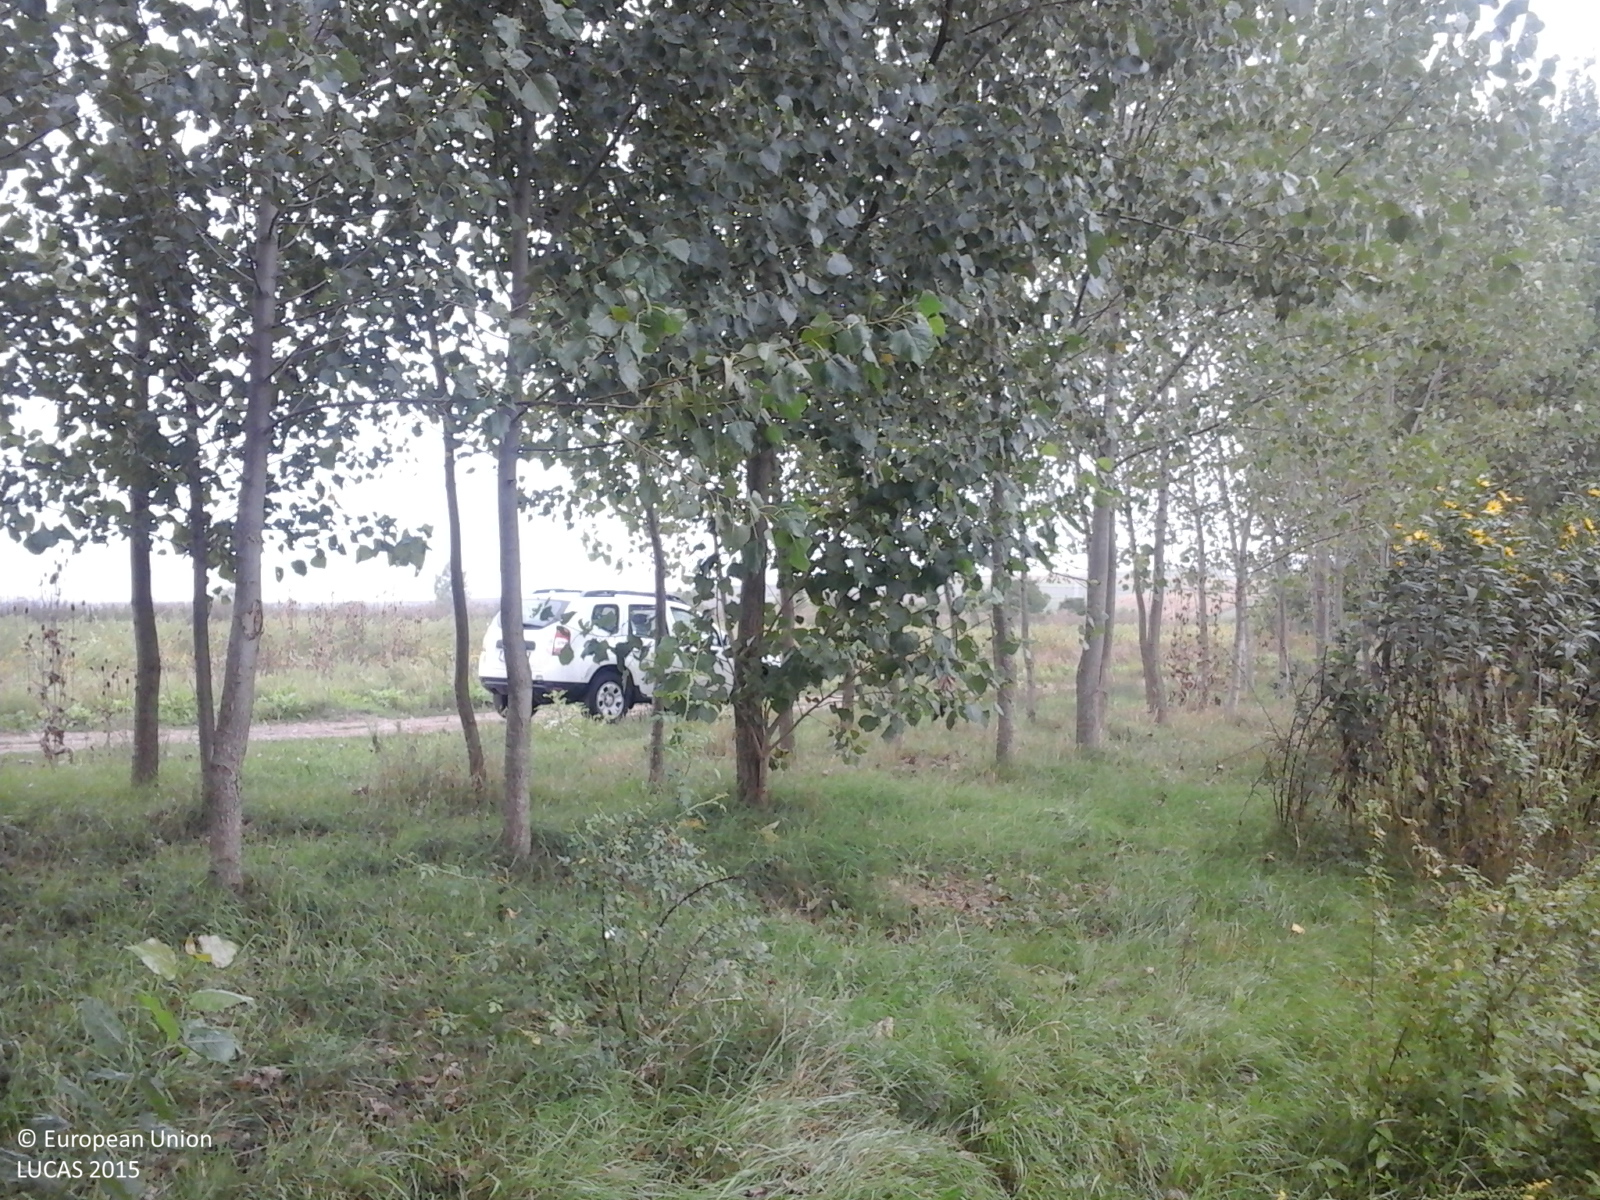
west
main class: Cropland
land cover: Maize
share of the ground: > 75 %
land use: Agriculture (excluding fallow land and kitchen gardens)
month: September
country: RO
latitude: 47.3881
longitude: 22.4416
